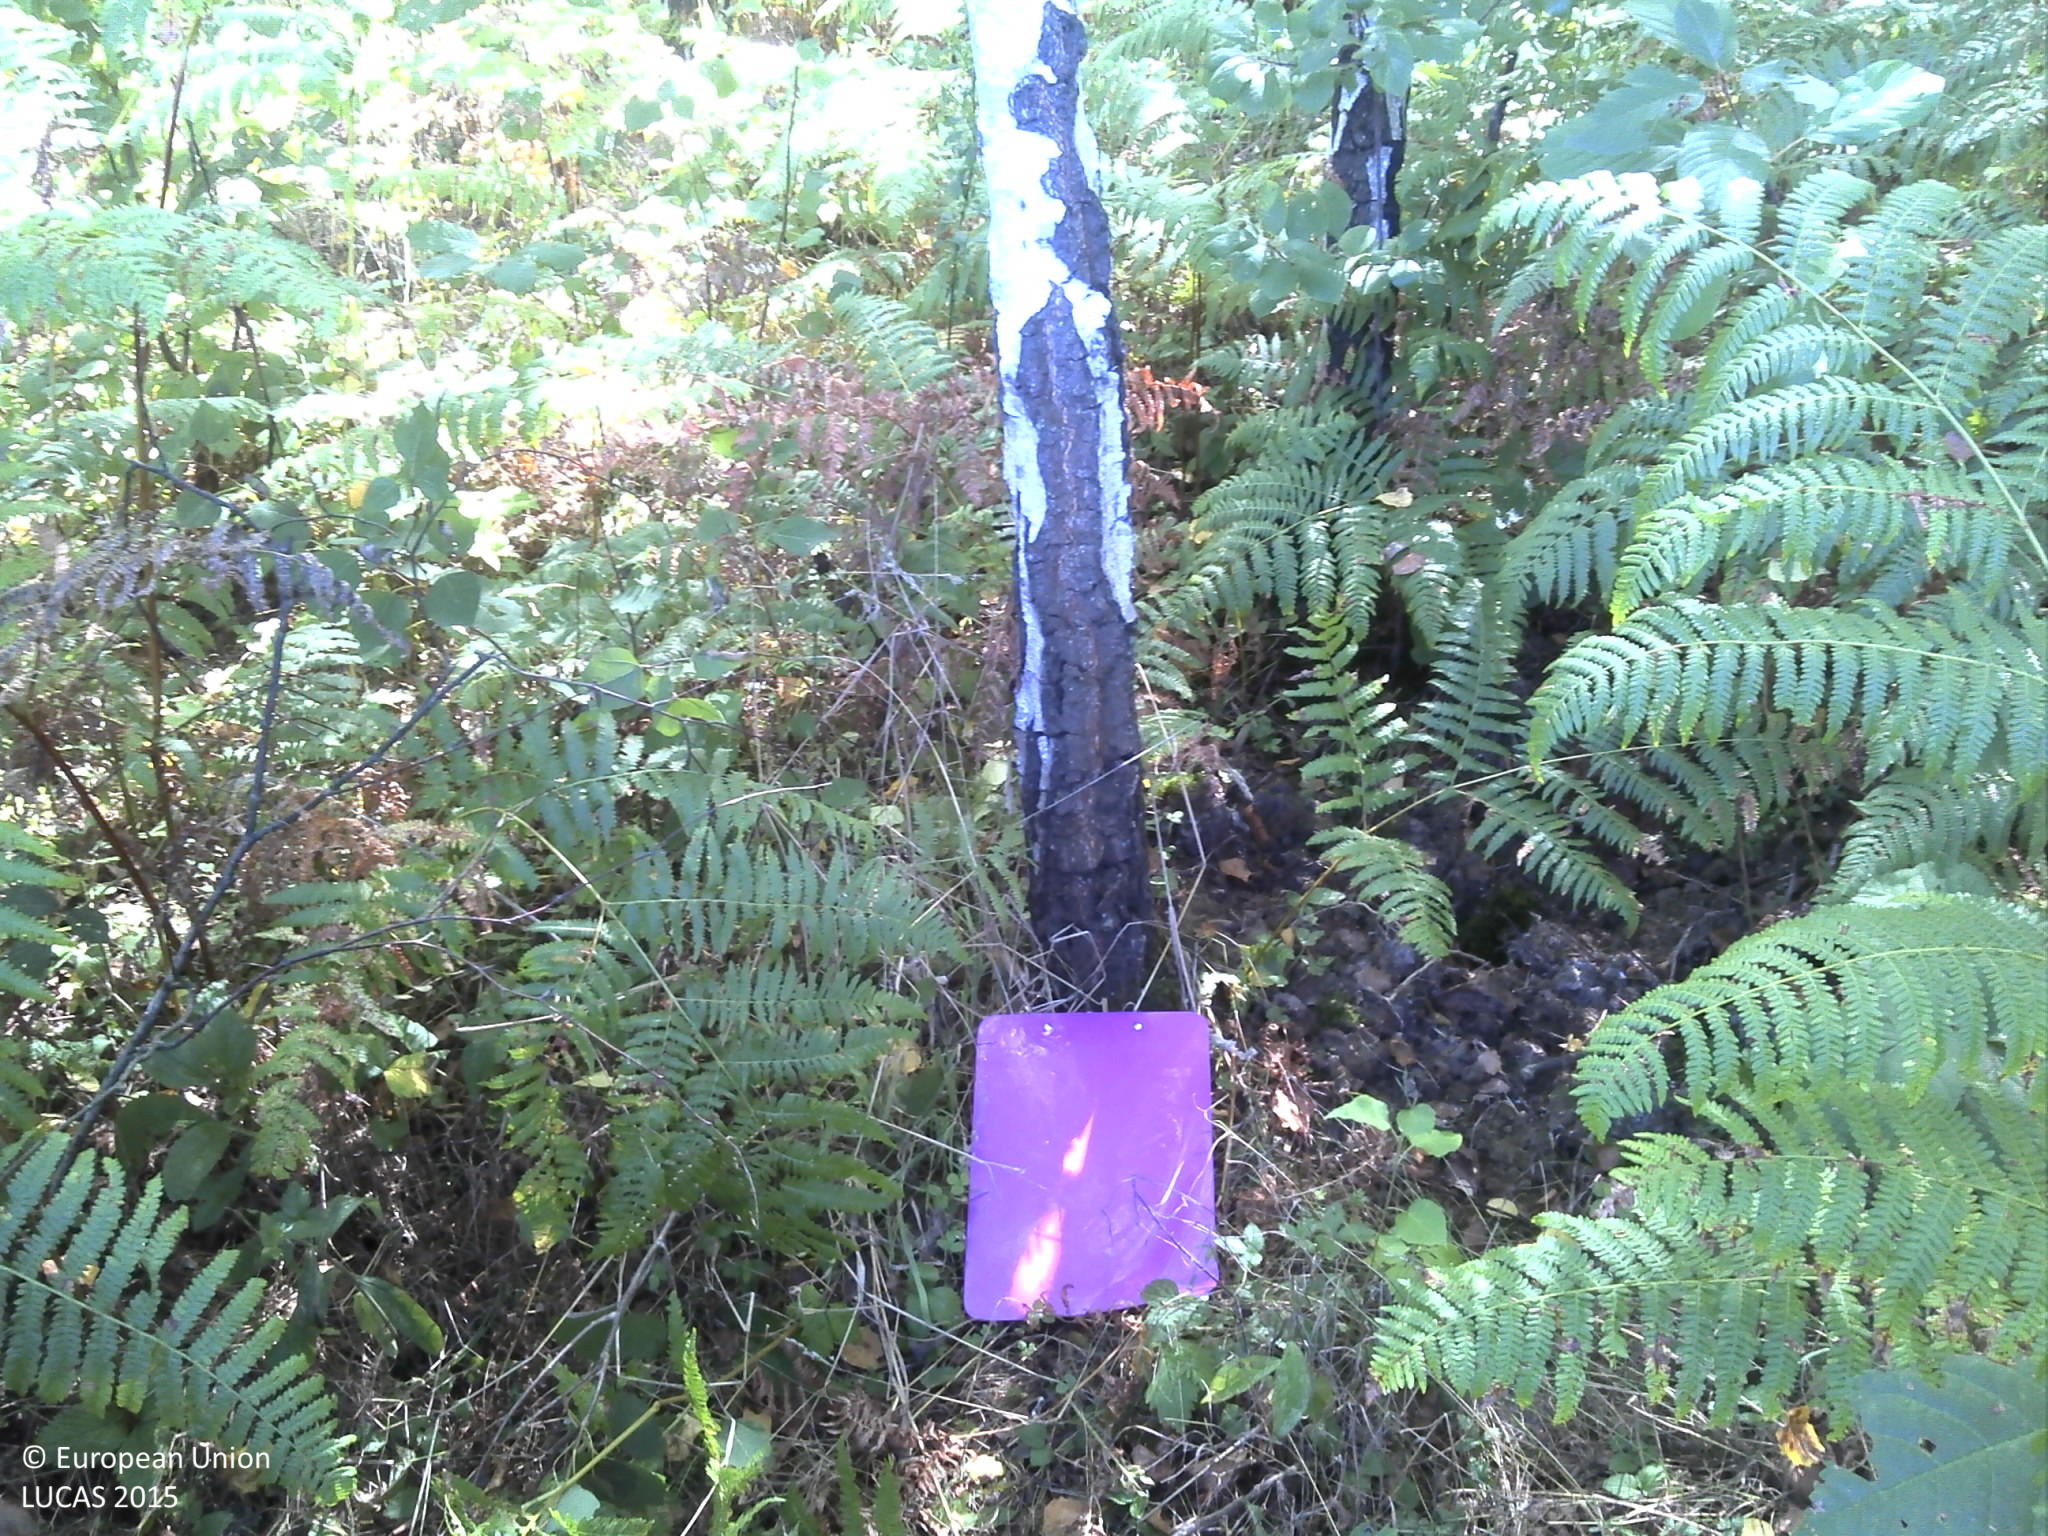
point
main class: Woodland
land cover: Broadleaved woodland
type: non-riverine alder, birch or aspen forest
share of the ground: > 75 %
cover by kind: broadleaved forest trees 100 %
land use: Forestry
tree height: > 5 m
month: August
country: HR
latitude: 45.2704
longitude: 16.4595
